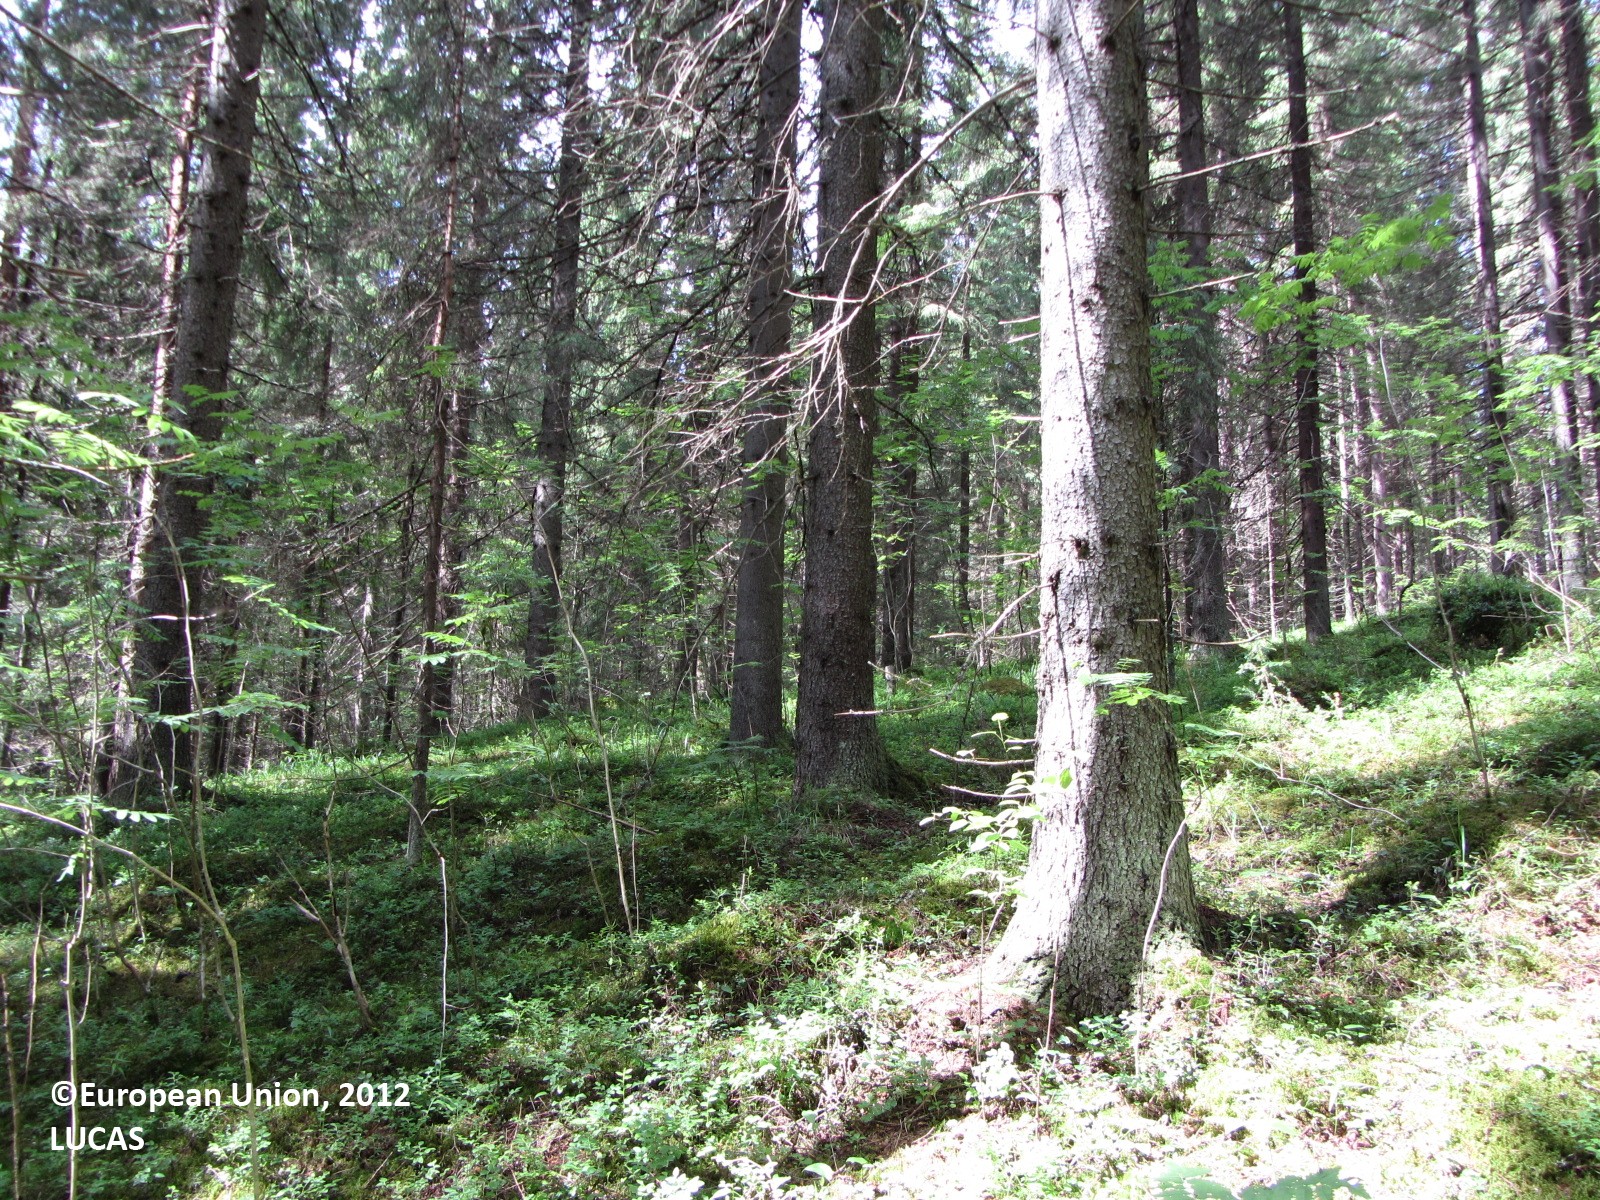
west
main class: Woodland
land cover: Spruce dominated coniferous woodland
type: boreal forest
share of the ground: > 75 %
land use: Forestry
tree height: > 5 m
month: June
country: FI
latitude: 61.9907
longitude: 25.2865
